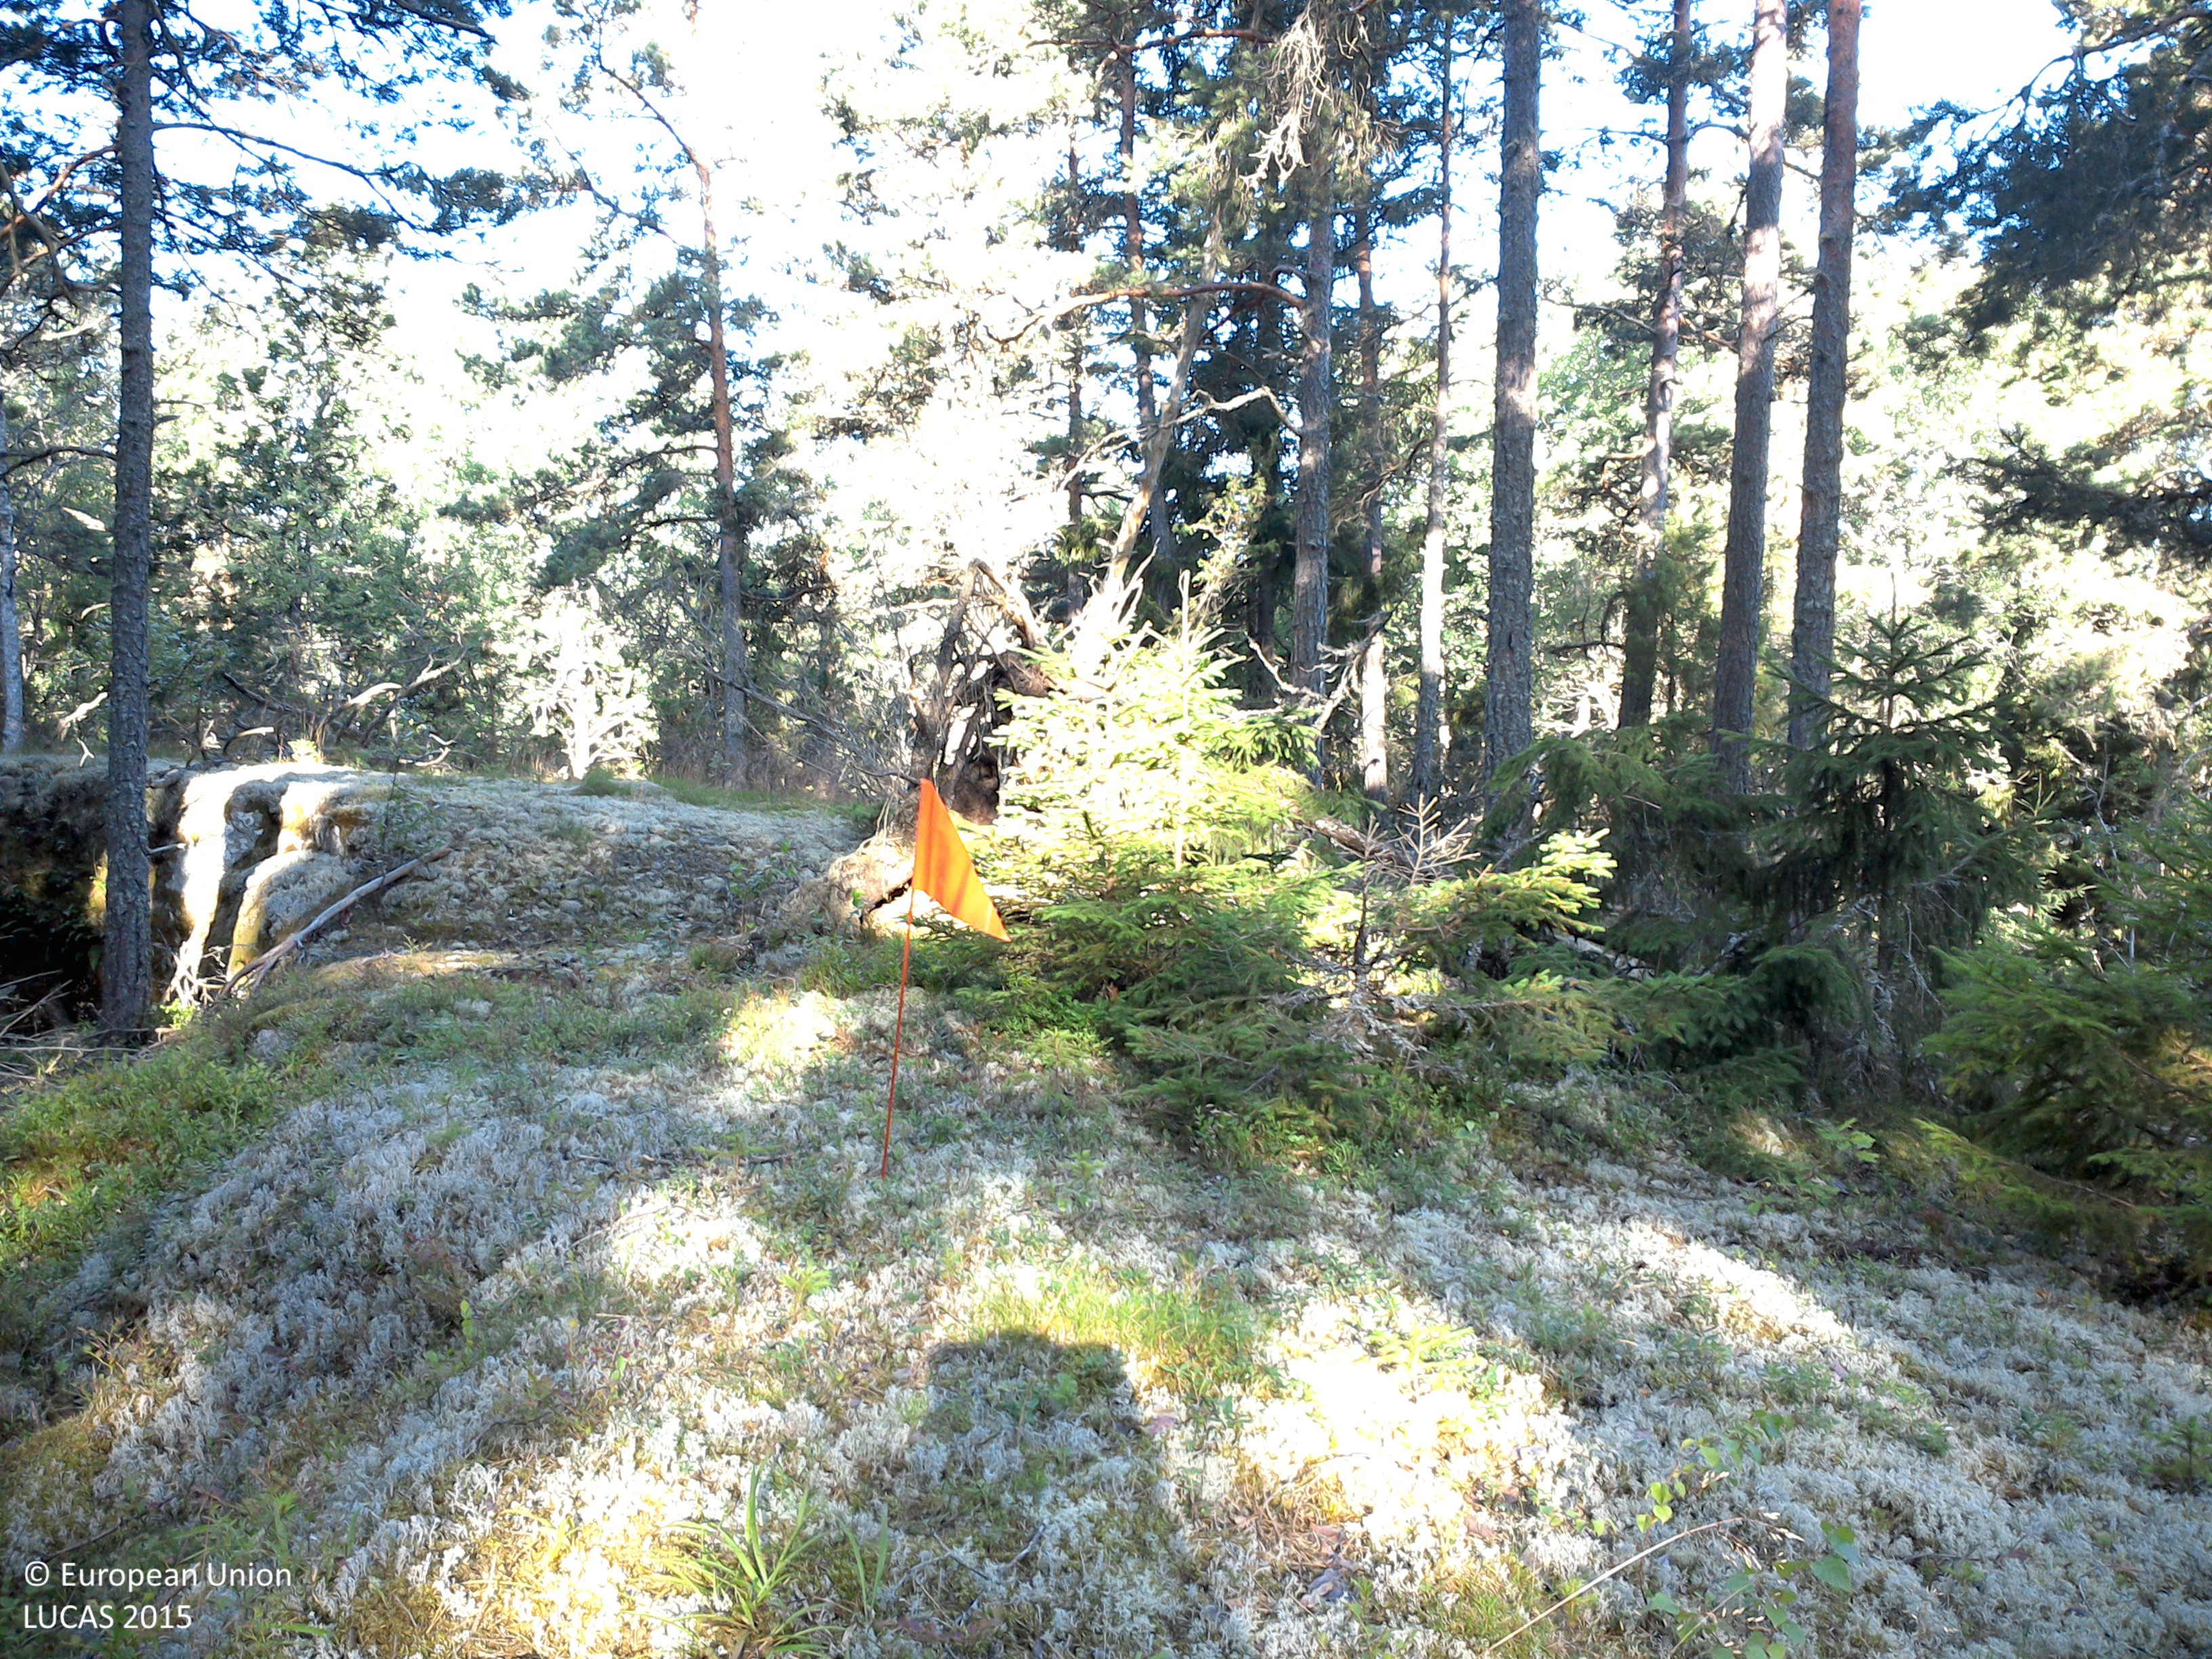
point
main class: Woodland
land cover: Pine dominated coniferous woodland
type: boreal forest
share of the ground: 50 - 75 %
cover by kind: coniferous forest trees 60 %, lichens and mosses 25 %, herbaceous plants 15 %
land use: Forestry
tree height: > 5 m
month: July
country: SE
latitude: 58.2402
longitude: 15.3262
